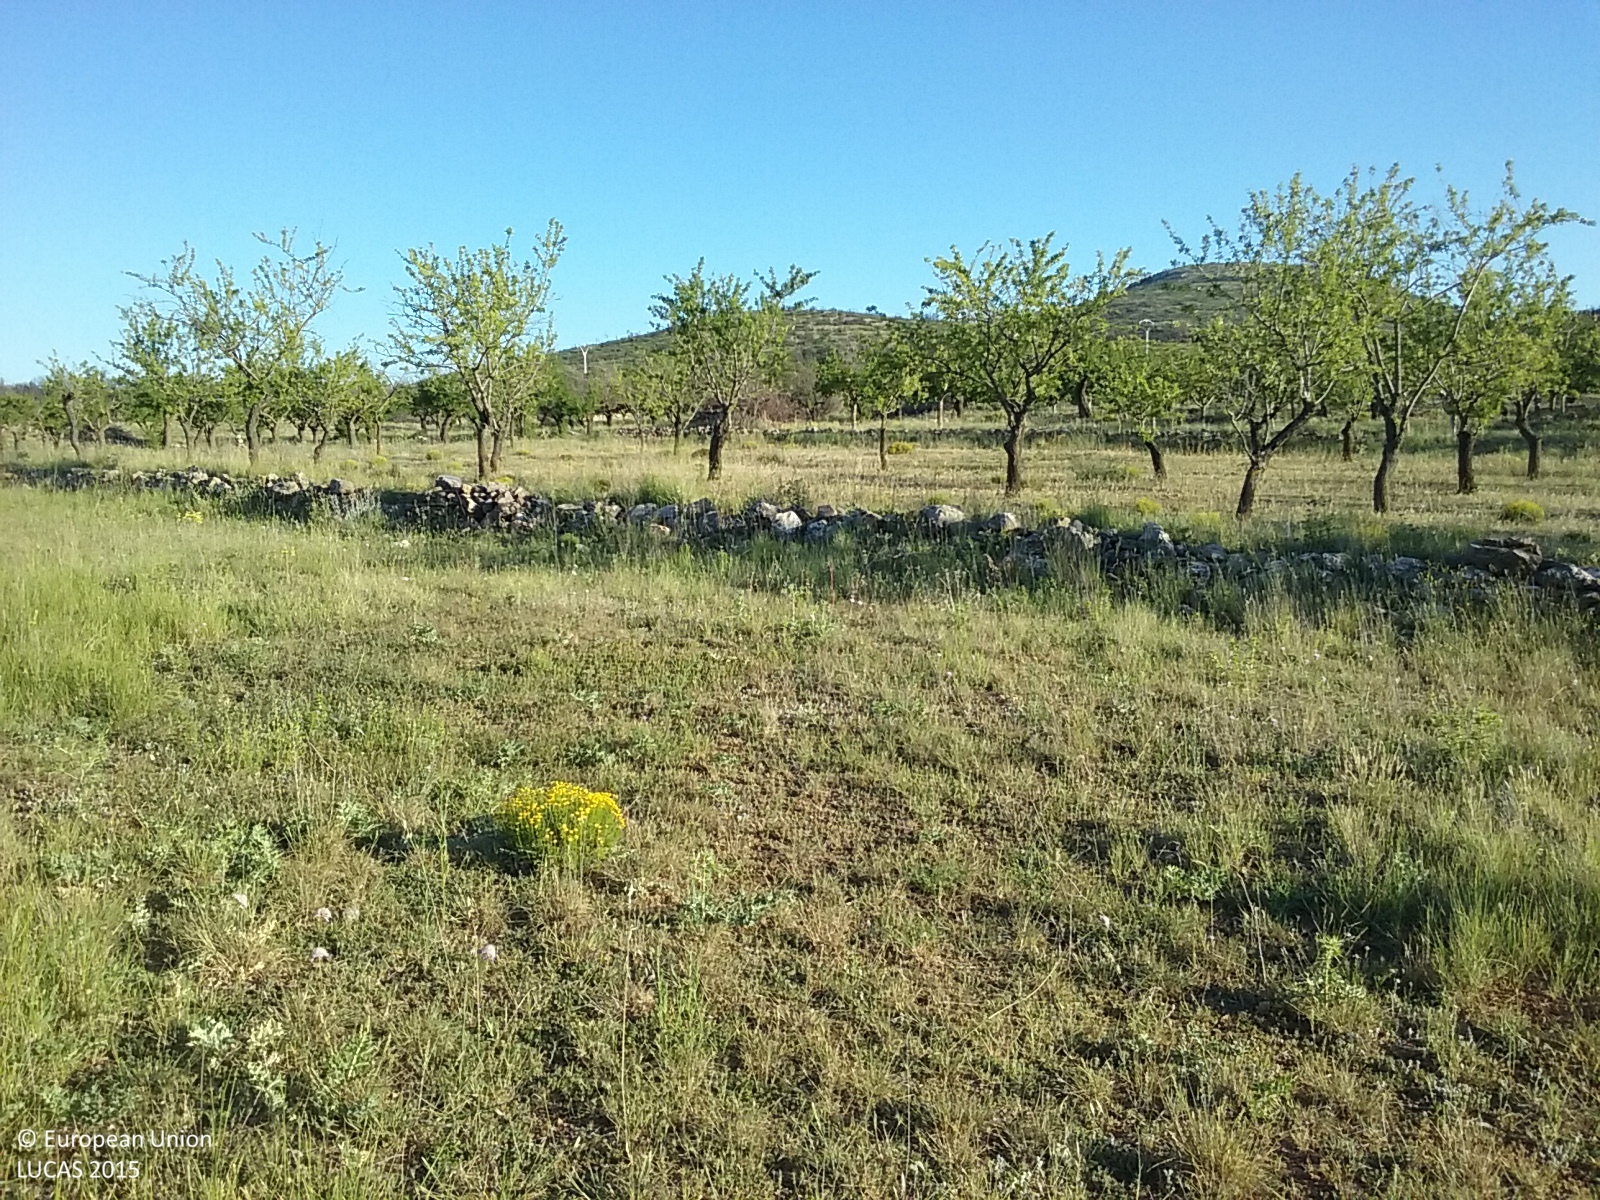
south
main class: Grassland
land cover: Spontaneously vegetated surfaces
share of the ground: > 75 %
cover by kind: herbaceous plants 90 %, shrubs 5 %, unconsolidated bare surface 5 %
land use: Abandoned areas
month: June
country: ES
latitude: 39.8450
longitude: -0.6963
